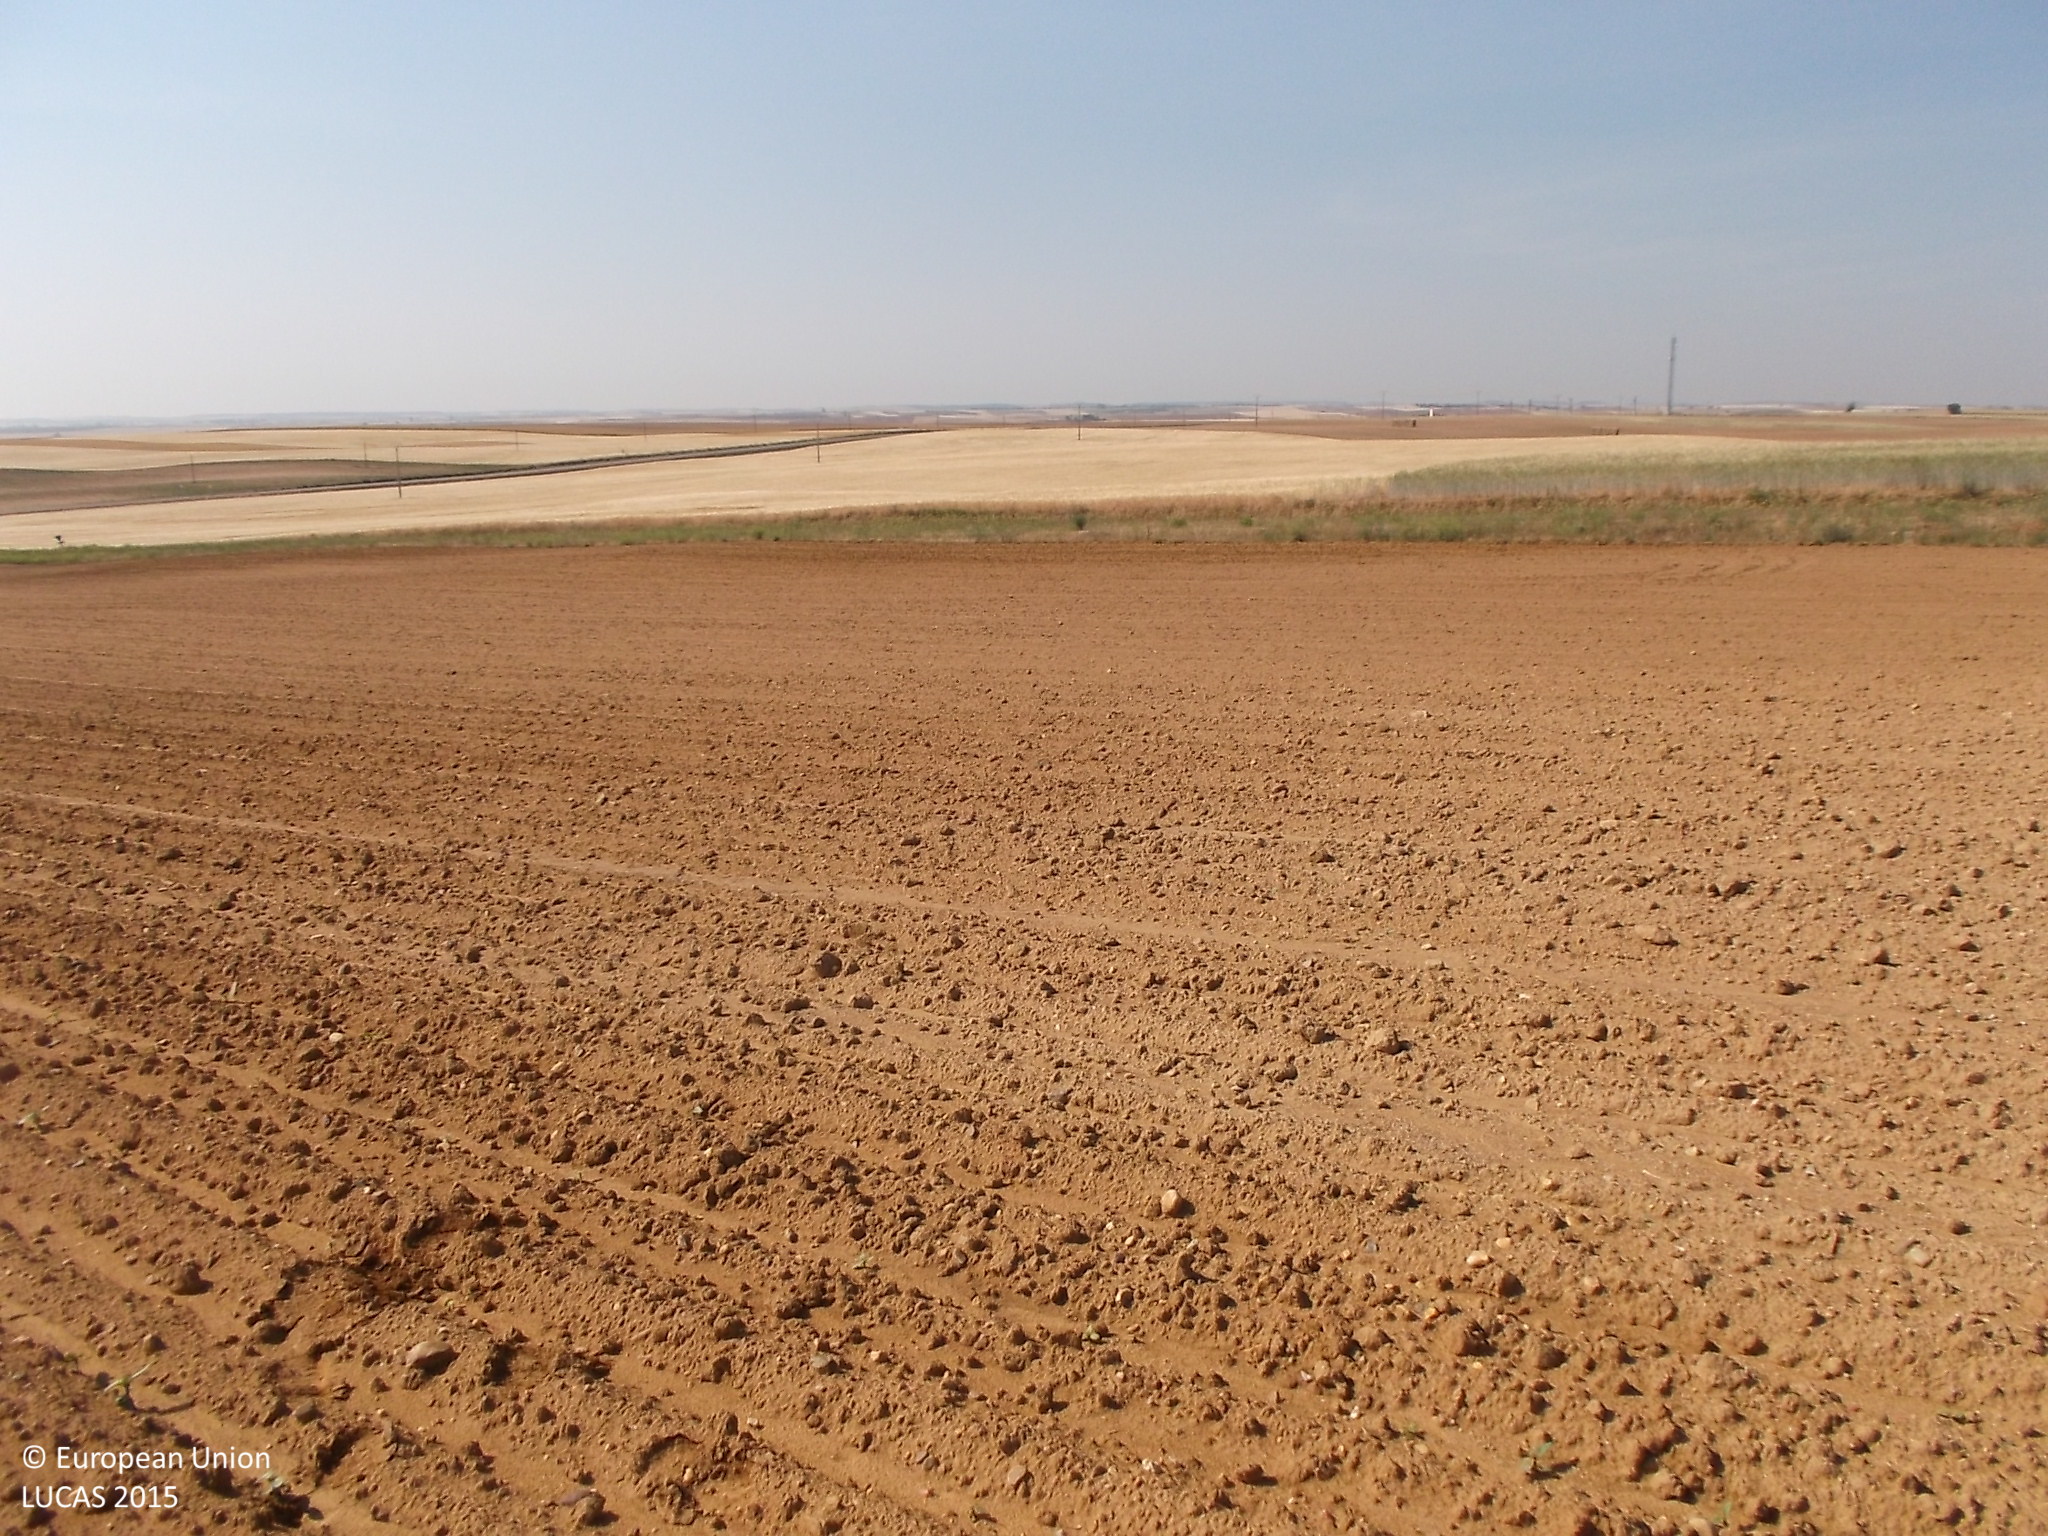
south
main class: Cropland
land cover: Sunflower
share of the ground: < 10 %
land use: Agriculture (excluding fallow land and kitchen gardens)
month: June
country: ES
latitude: 41.3168
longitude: -5.4280
